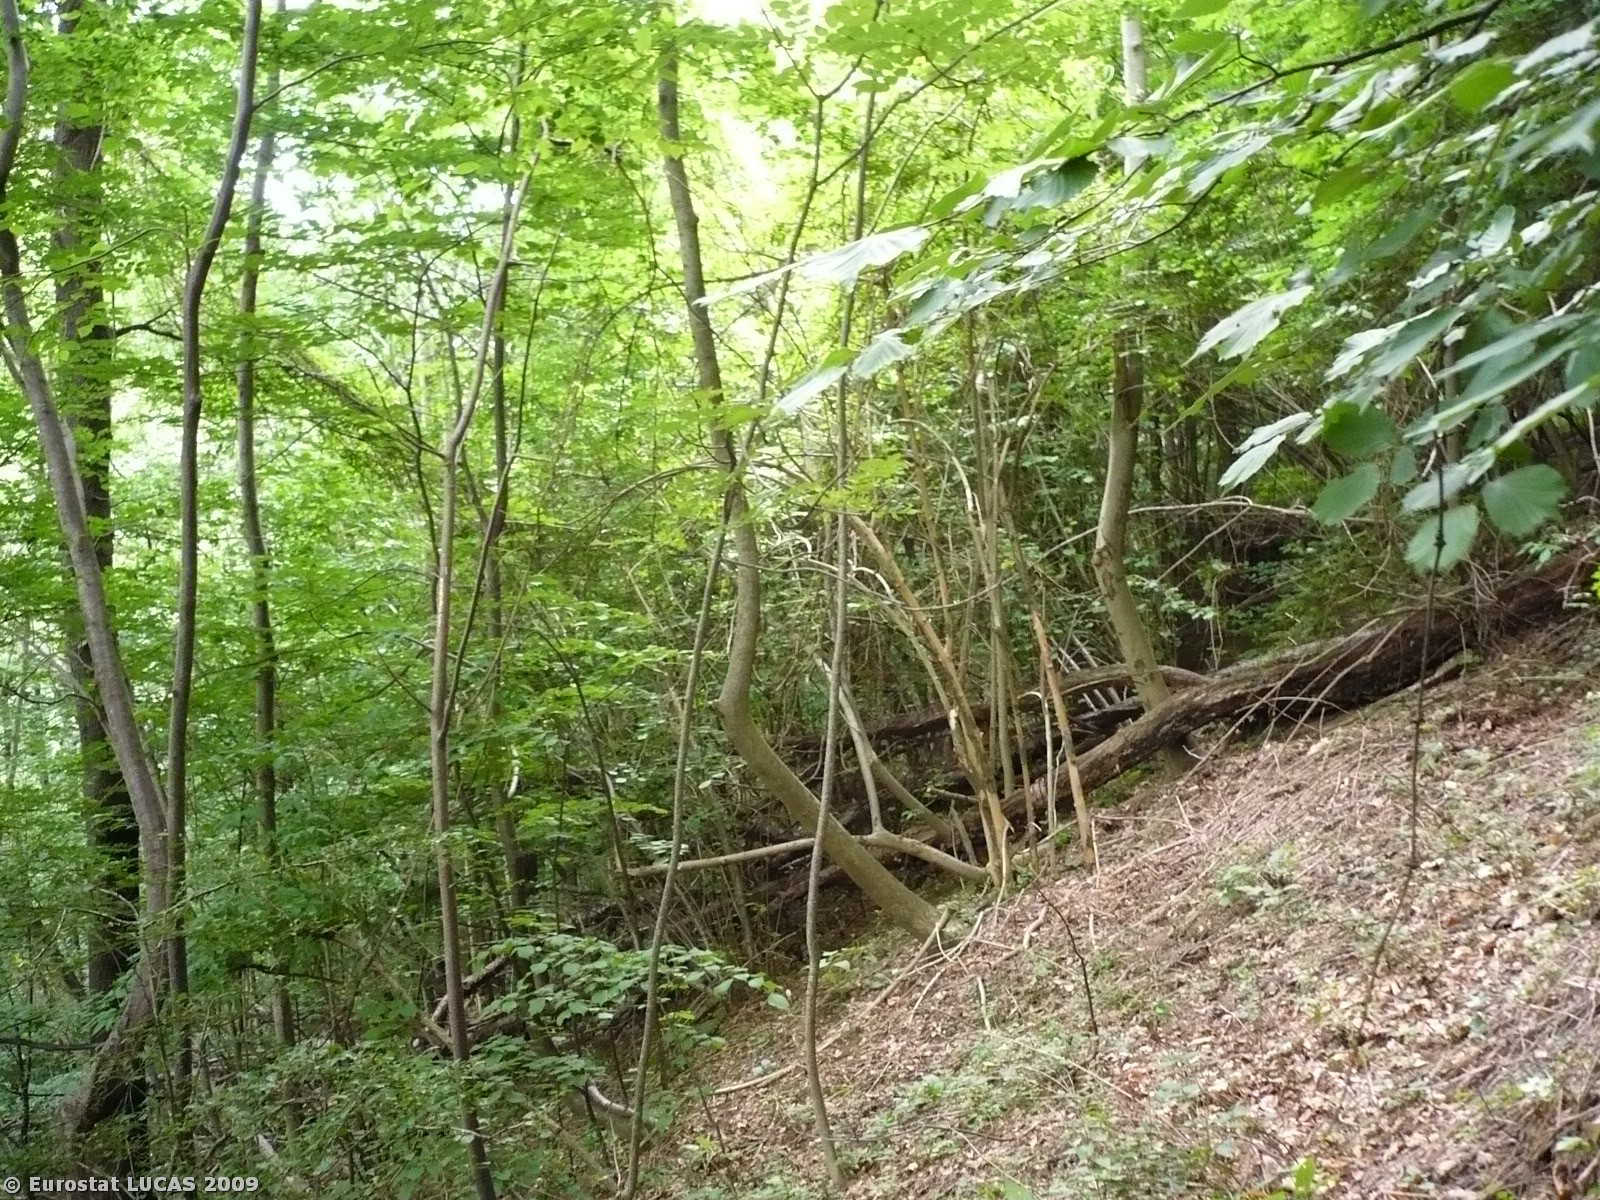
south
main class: Woodland
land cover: Broadleaved woodland
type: beech forest
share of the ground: > 75 %
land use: Unused
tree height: > 5 m
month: June
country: SI
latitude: 46.1255
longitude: 13.6848
